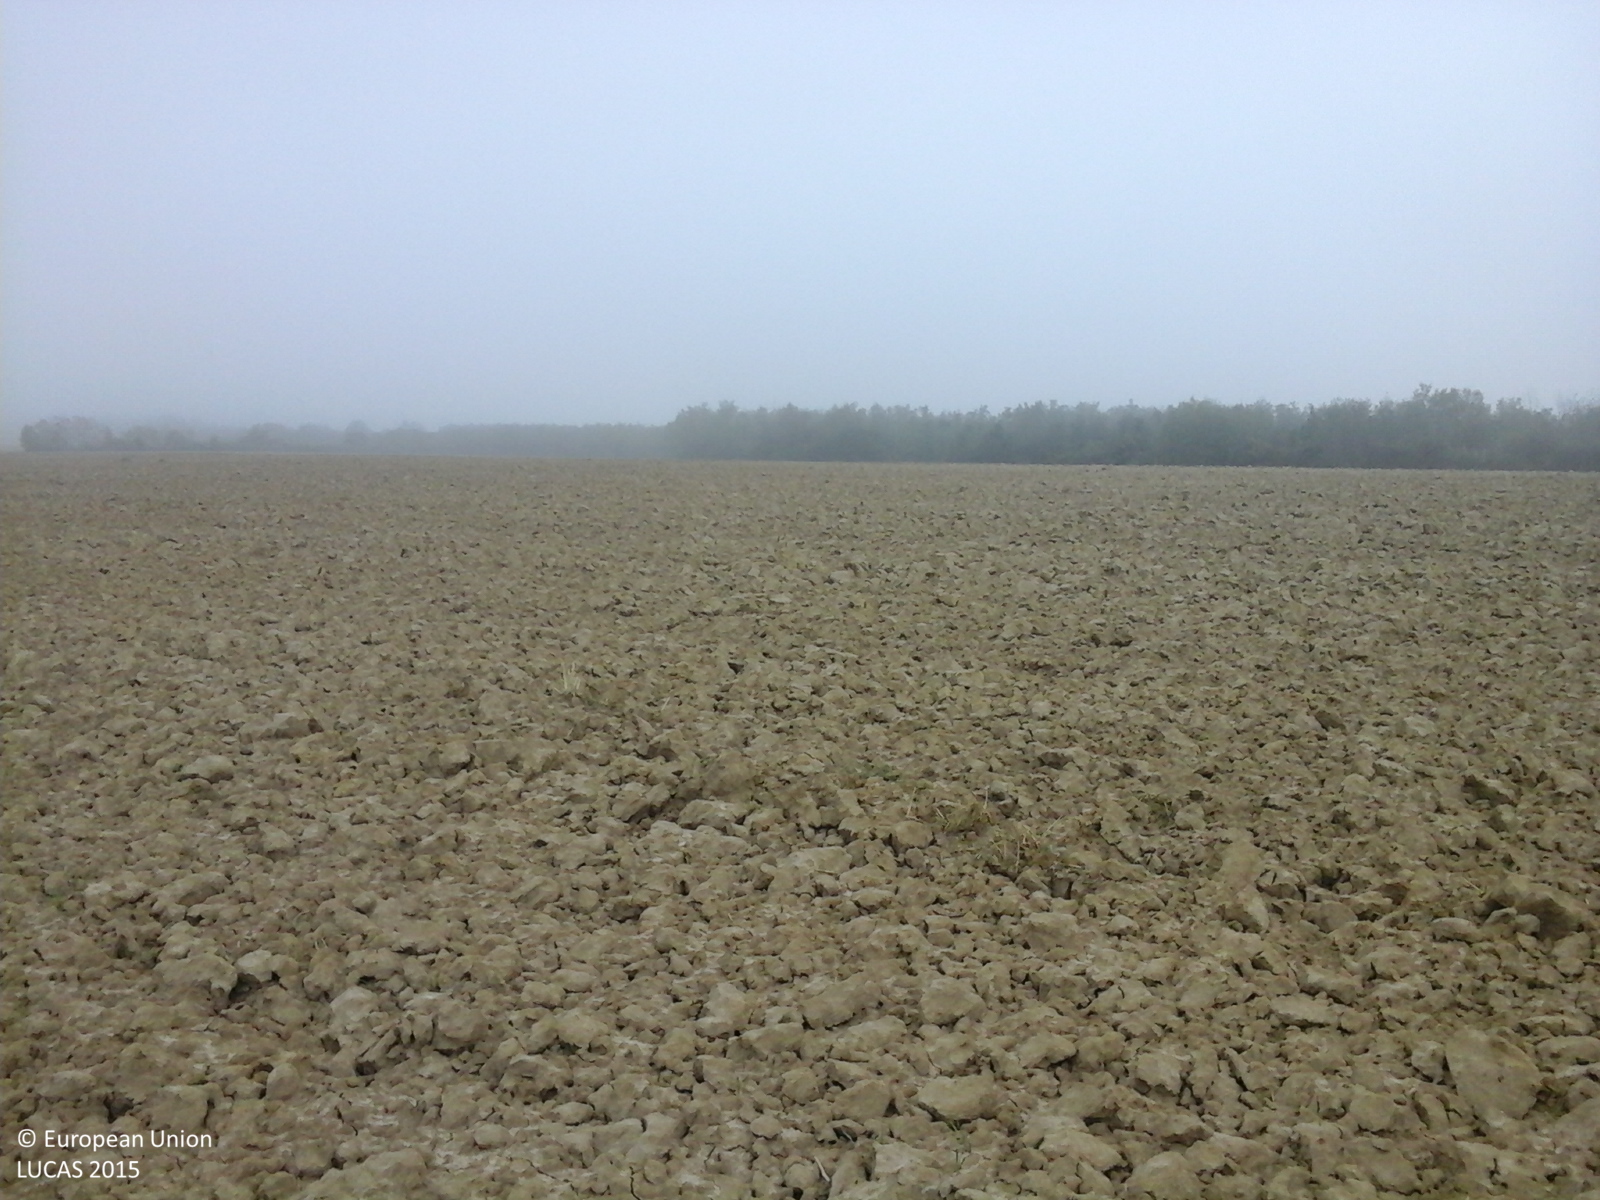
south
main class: Cropland
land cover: Common wheat
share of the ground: < 10 %
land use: Agriculture (excluding fallow land and kitchen gardens)
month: September
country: RO
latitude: 45.5616
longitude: 22.0180
